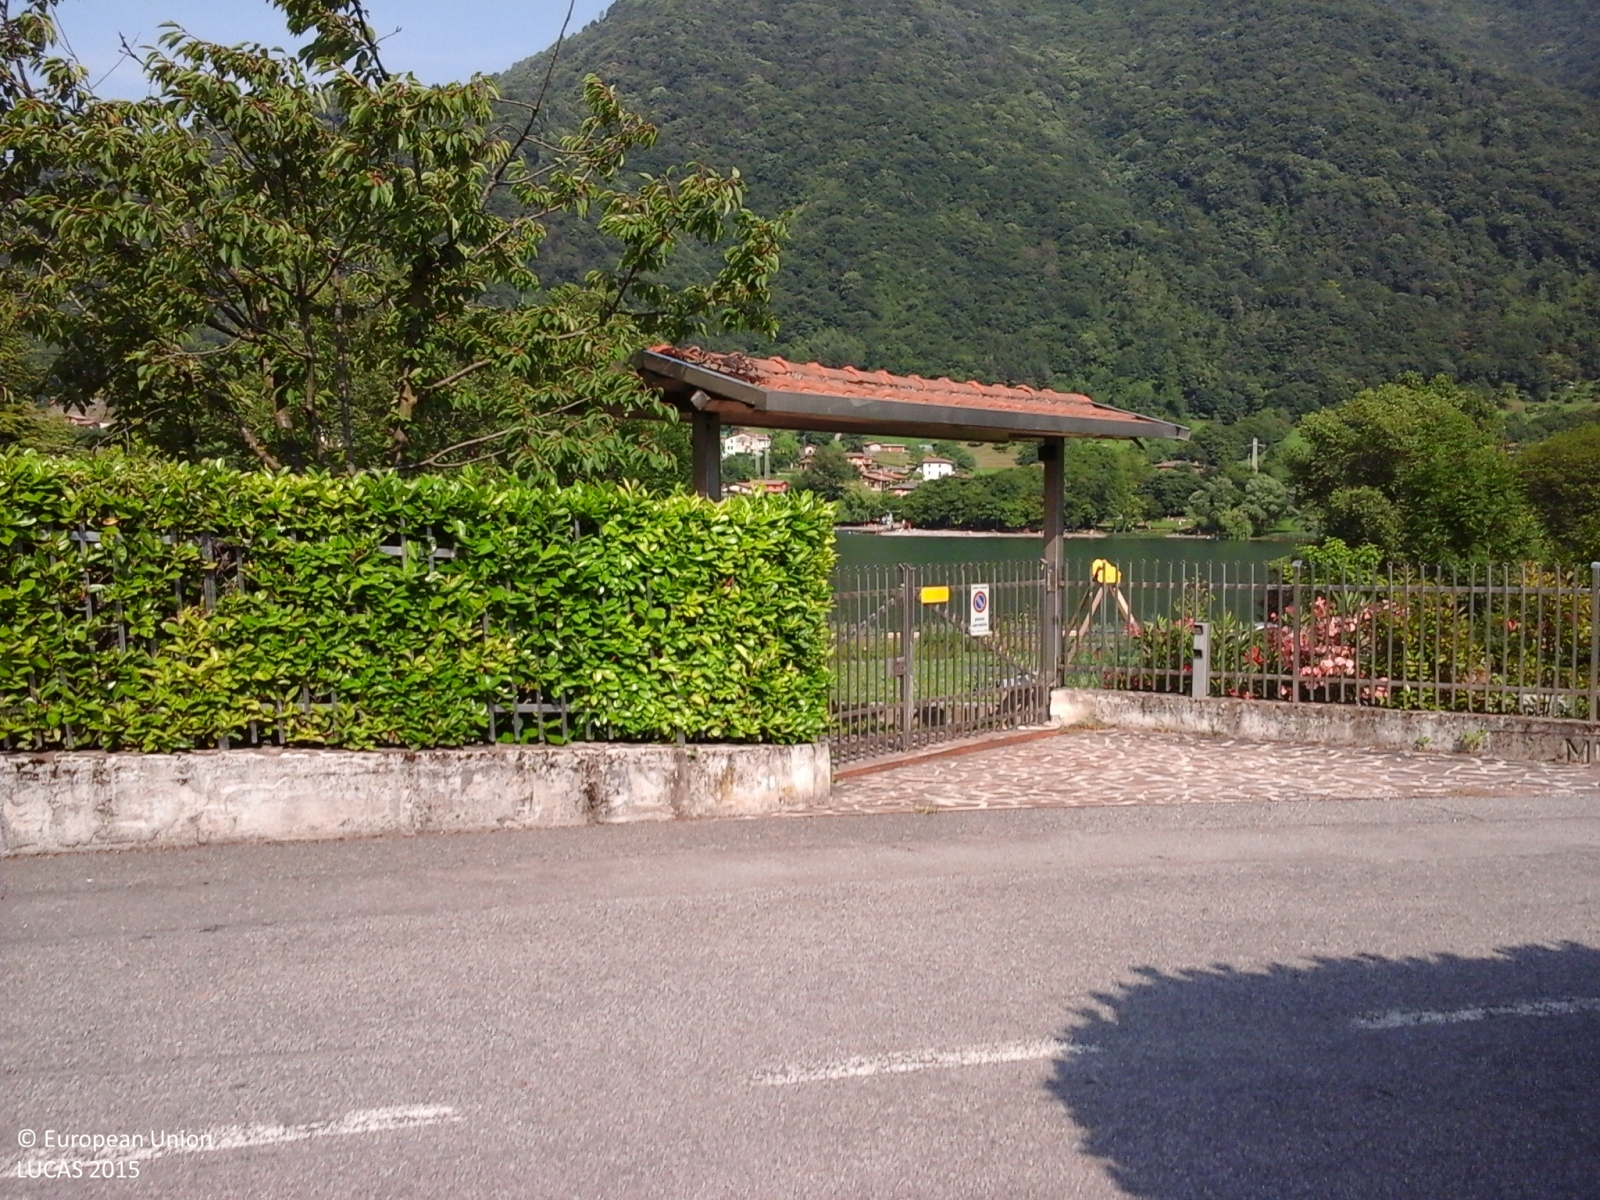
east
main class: Grassland
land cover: Grassland with sparse tree/shrub cover
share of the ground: > 75 %
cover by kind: herbaceous plants 95 %, coniferous forest trees 5 %
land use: Residential
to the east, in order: Grassland with sparse tree/shrub cover; Managed hedges; Artificial constructions; Paved roads, cycling and walking lanes; Fences; Grassland without tree/shrub cover; Paved roads, cycling and walking lanes; Grassland without tree/shrub cover; Inland marshes; Inland fresh water bodies
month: June
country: IT
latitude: 45.7747
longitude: 9.9358
